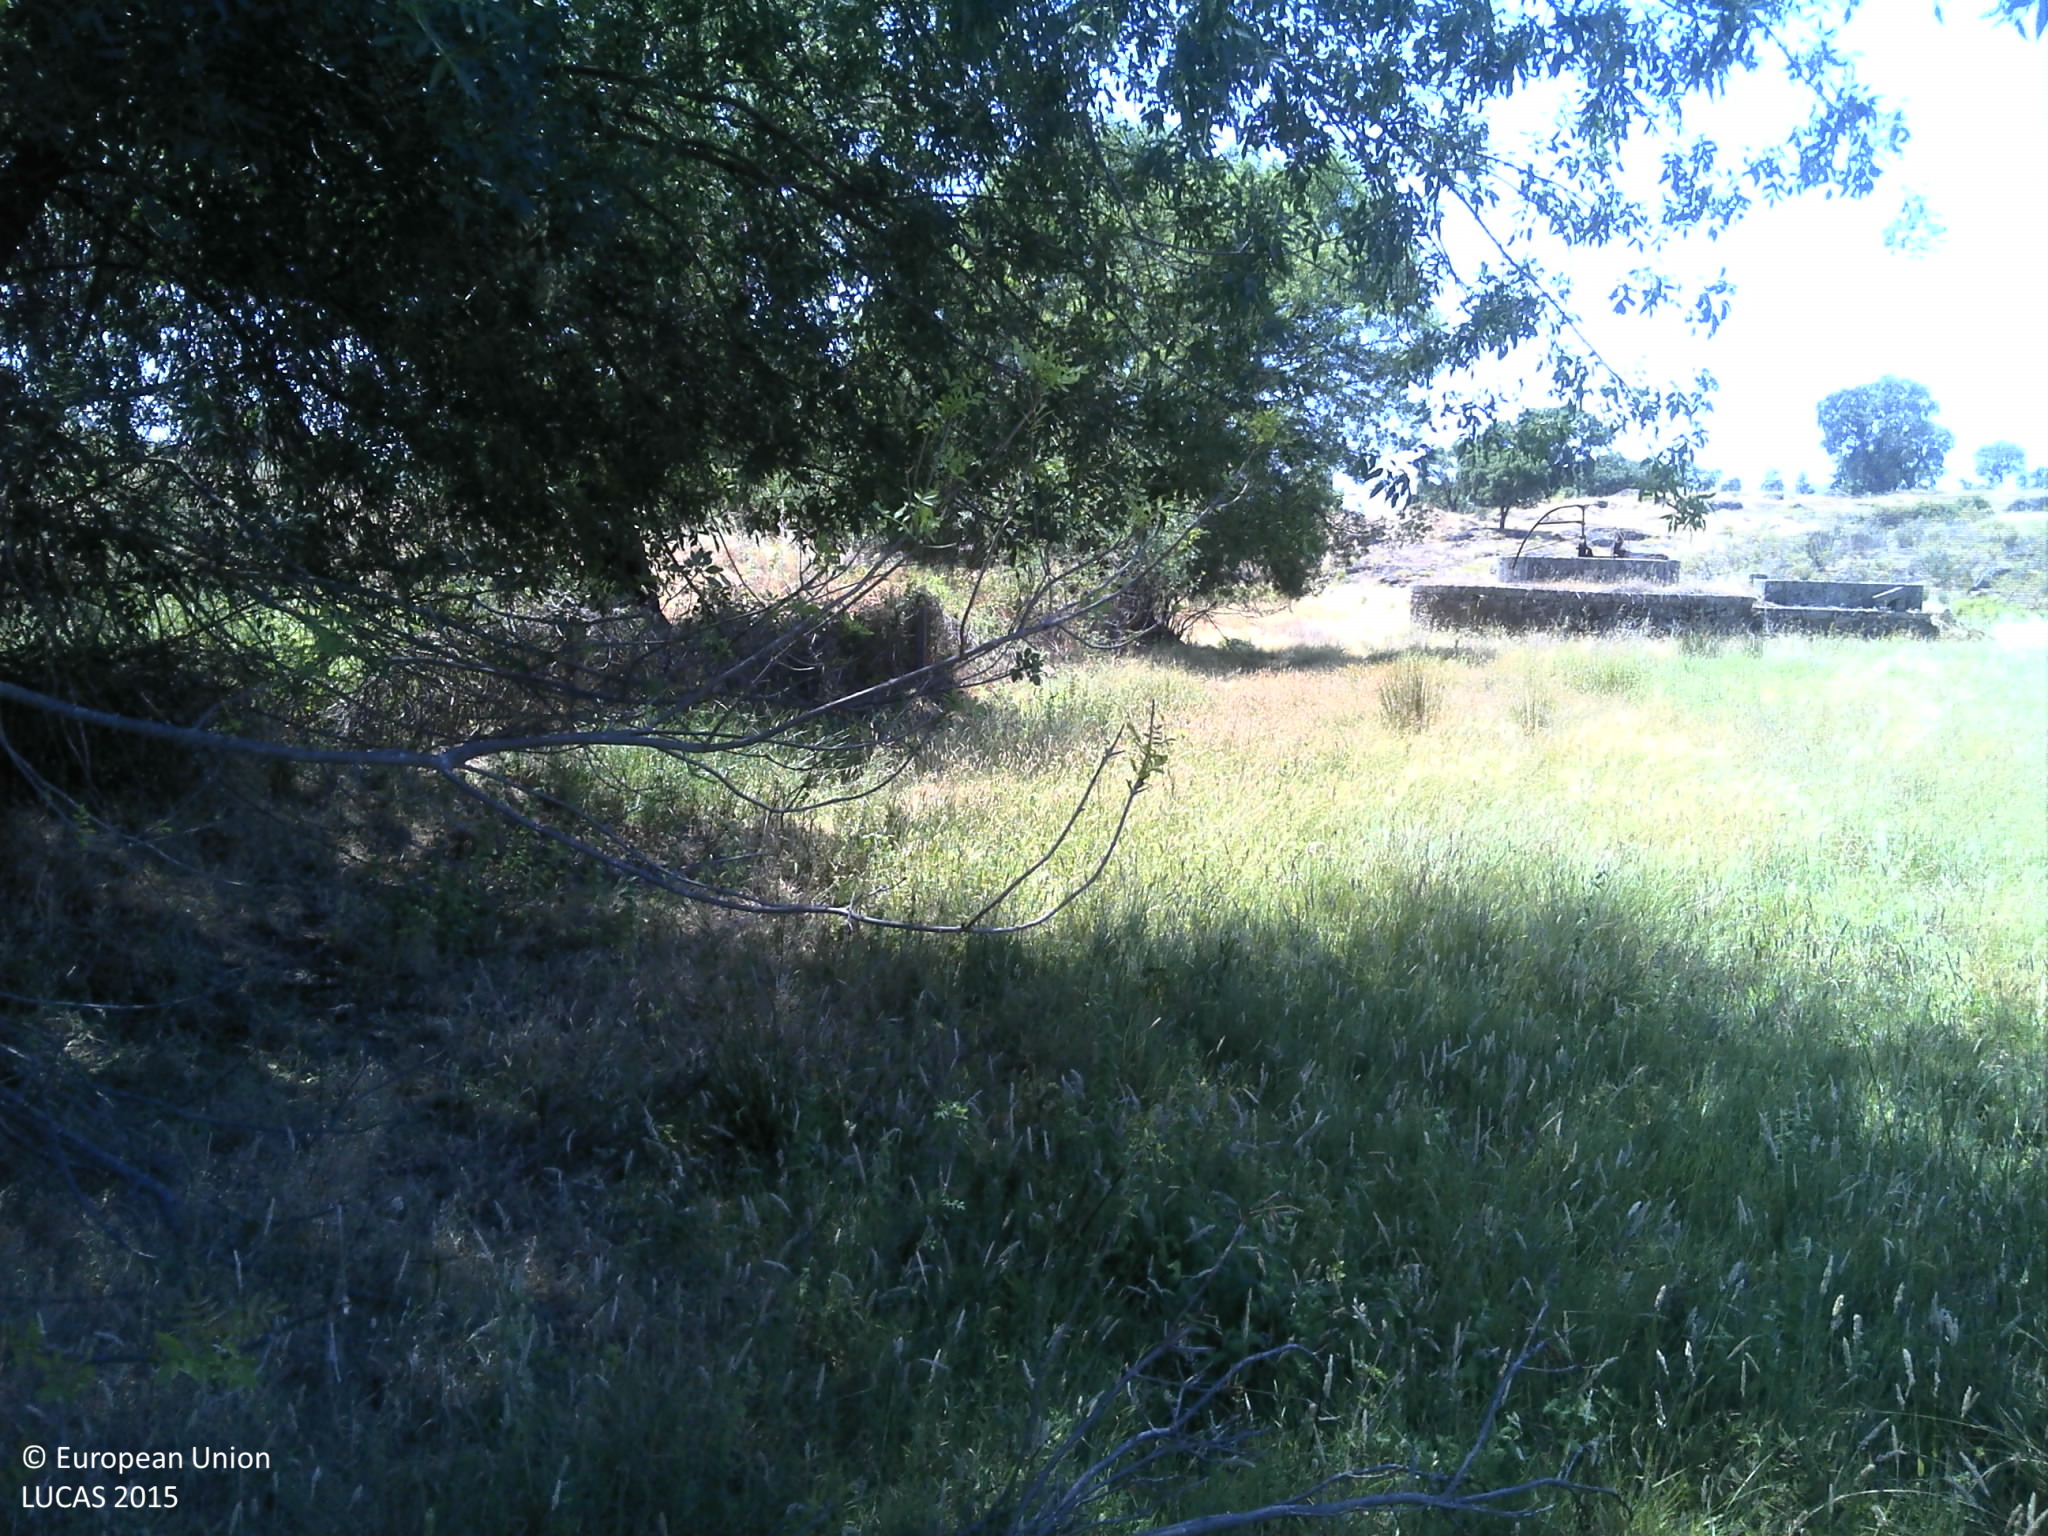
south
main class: Grassland
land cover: Grassland without tree/shrub cover
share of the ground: 50 - 75 %
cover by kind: herbaceous plants 60 %, unconsolidated bare surface 30 %, shrubs 5 %
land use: Agriculture (excluding fallow land and kitchen gardens)
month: June
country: PT
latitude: 39.8816
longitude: -7.3917
